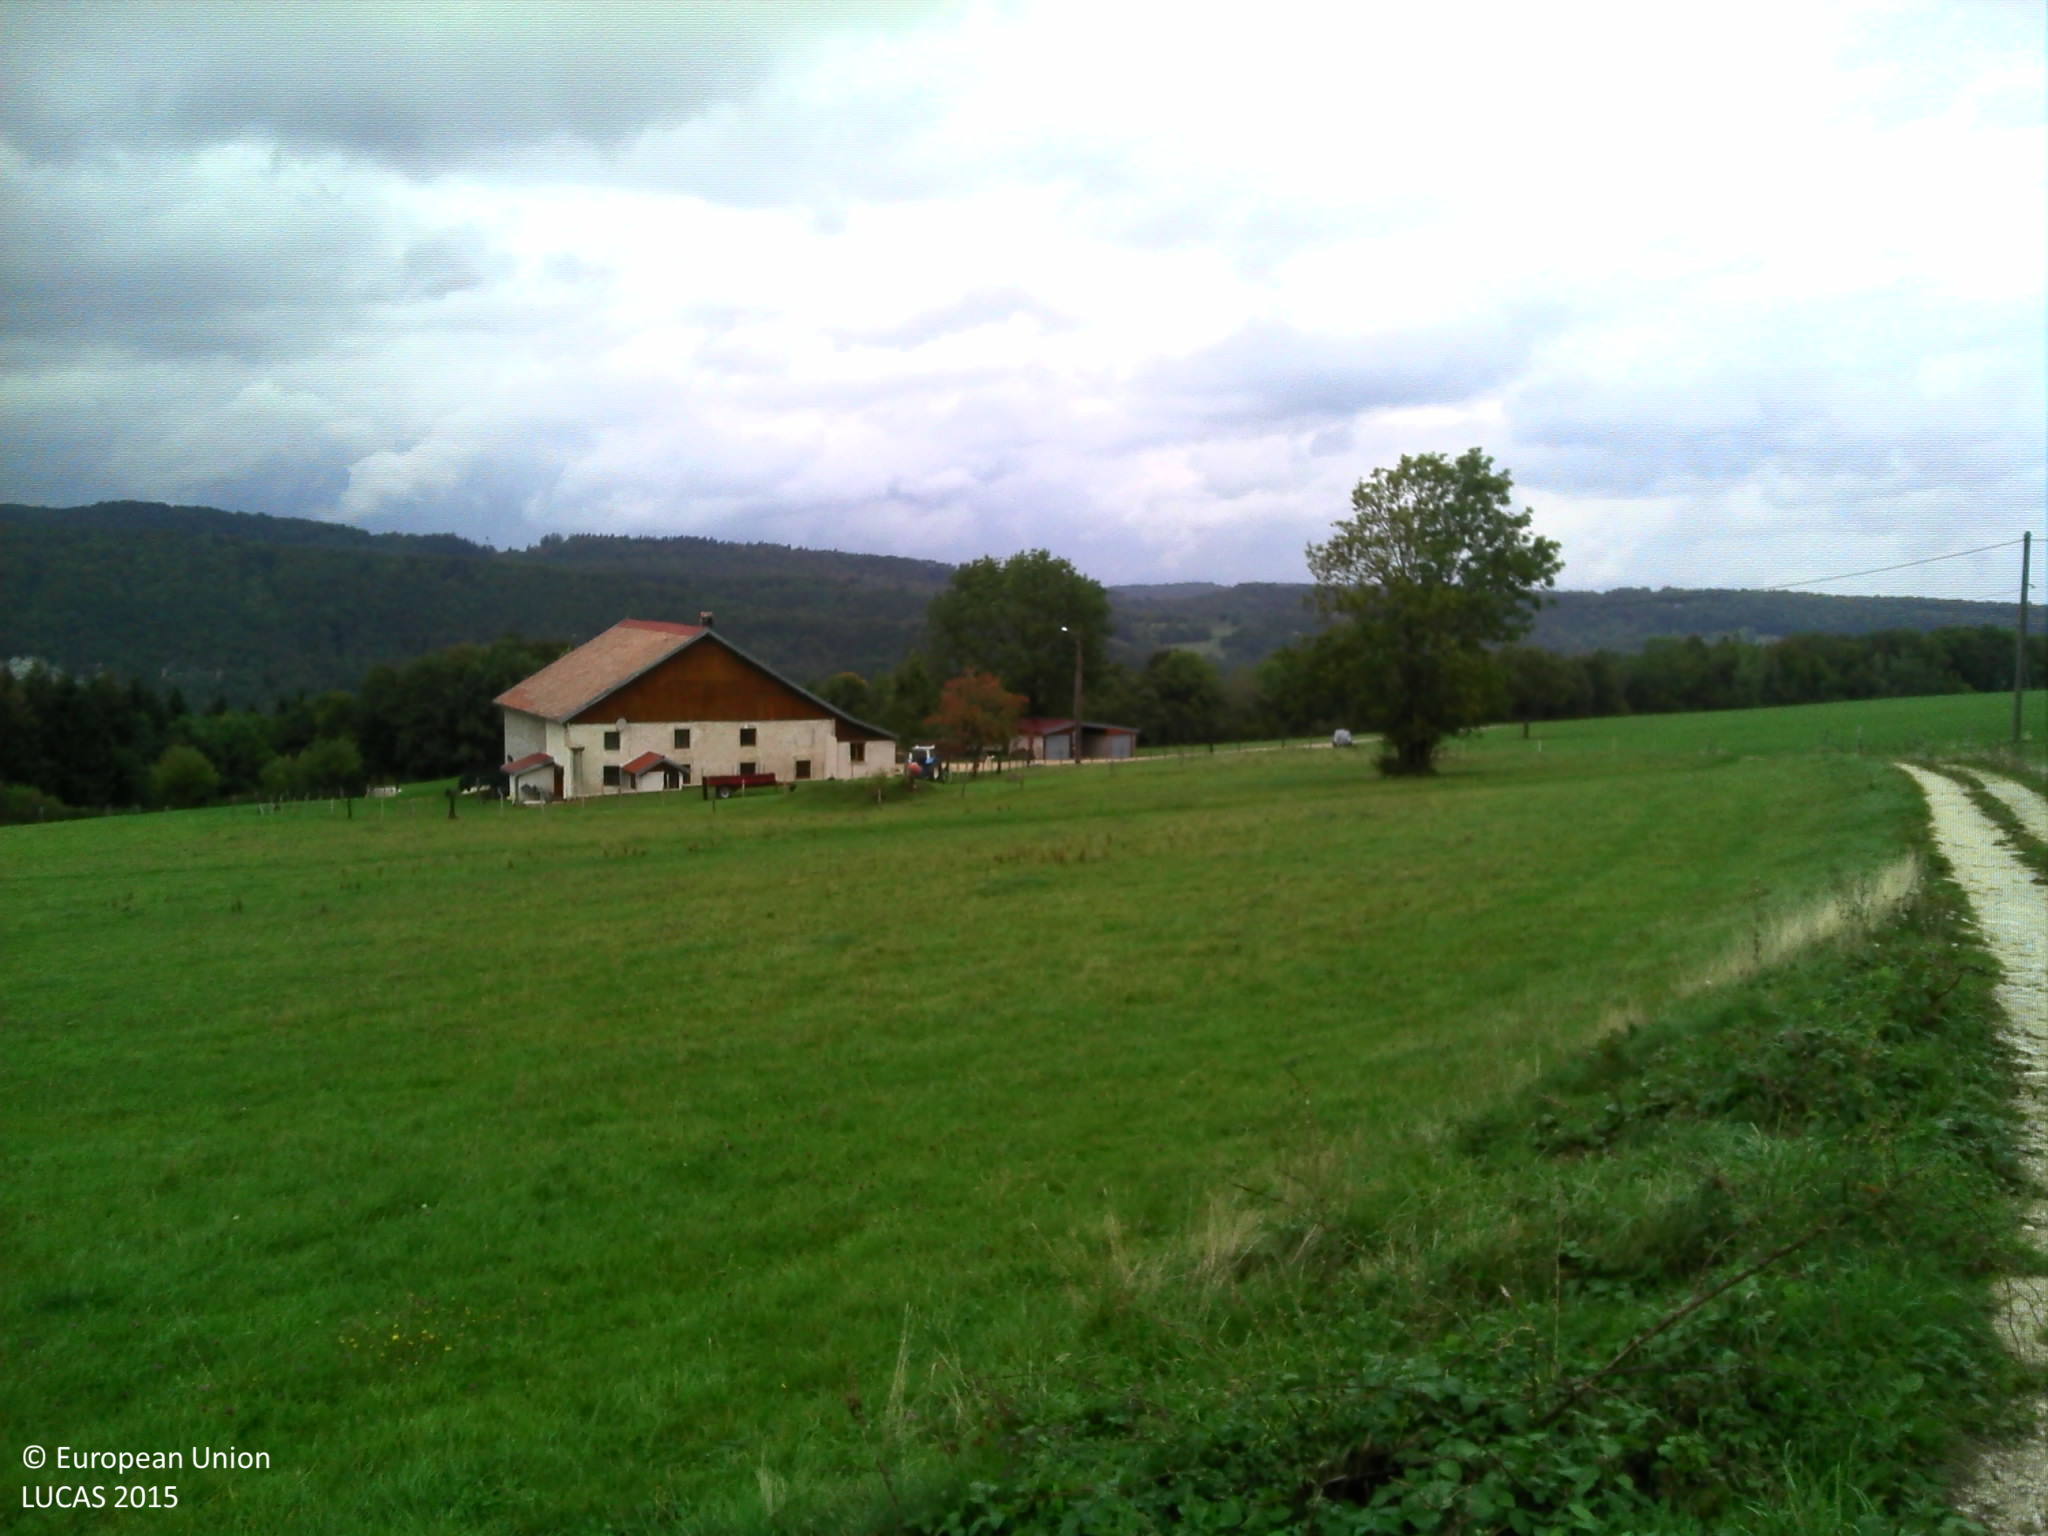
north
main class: Grassland
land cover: Grassland without tree/shrub cover
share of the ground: > 75 %
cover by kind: herbaceous plants 100 %
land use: Agriculture (excluding fallow land and kitchen gardens)
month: September
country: FR
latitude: 47.3332
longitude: 6.8920
